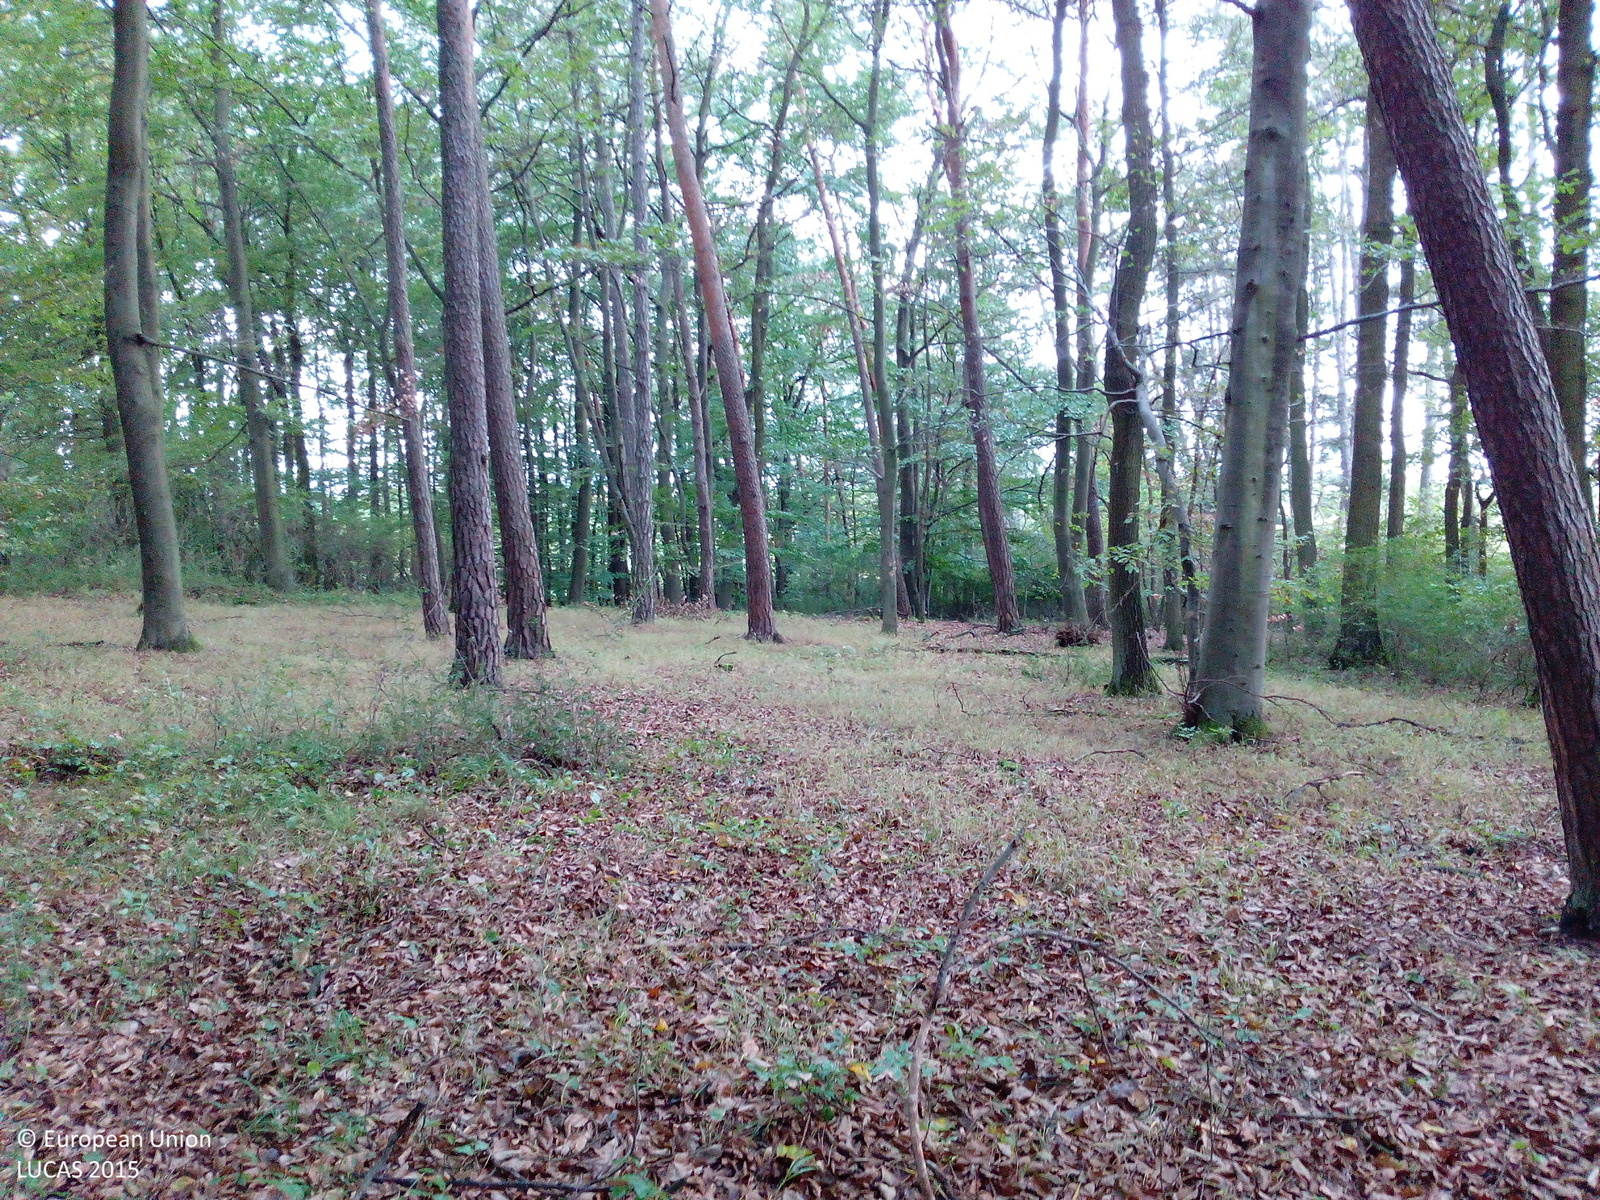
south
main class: Woodland
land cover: Pine dominated mixed woodland
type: hemiboreal forest and nemoral coniferous forest and mixed broadleaved-coniferous forest
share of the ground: > 75 %
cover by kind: broadleaved forest trees 45 %, coniferous forest trees 35 %, herbaceous plants 10 %, unconsolidated bare surface 10 %
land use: Forestry
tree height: > 5 m
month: September
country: DE
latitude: 49.9324
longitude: 9.9025
